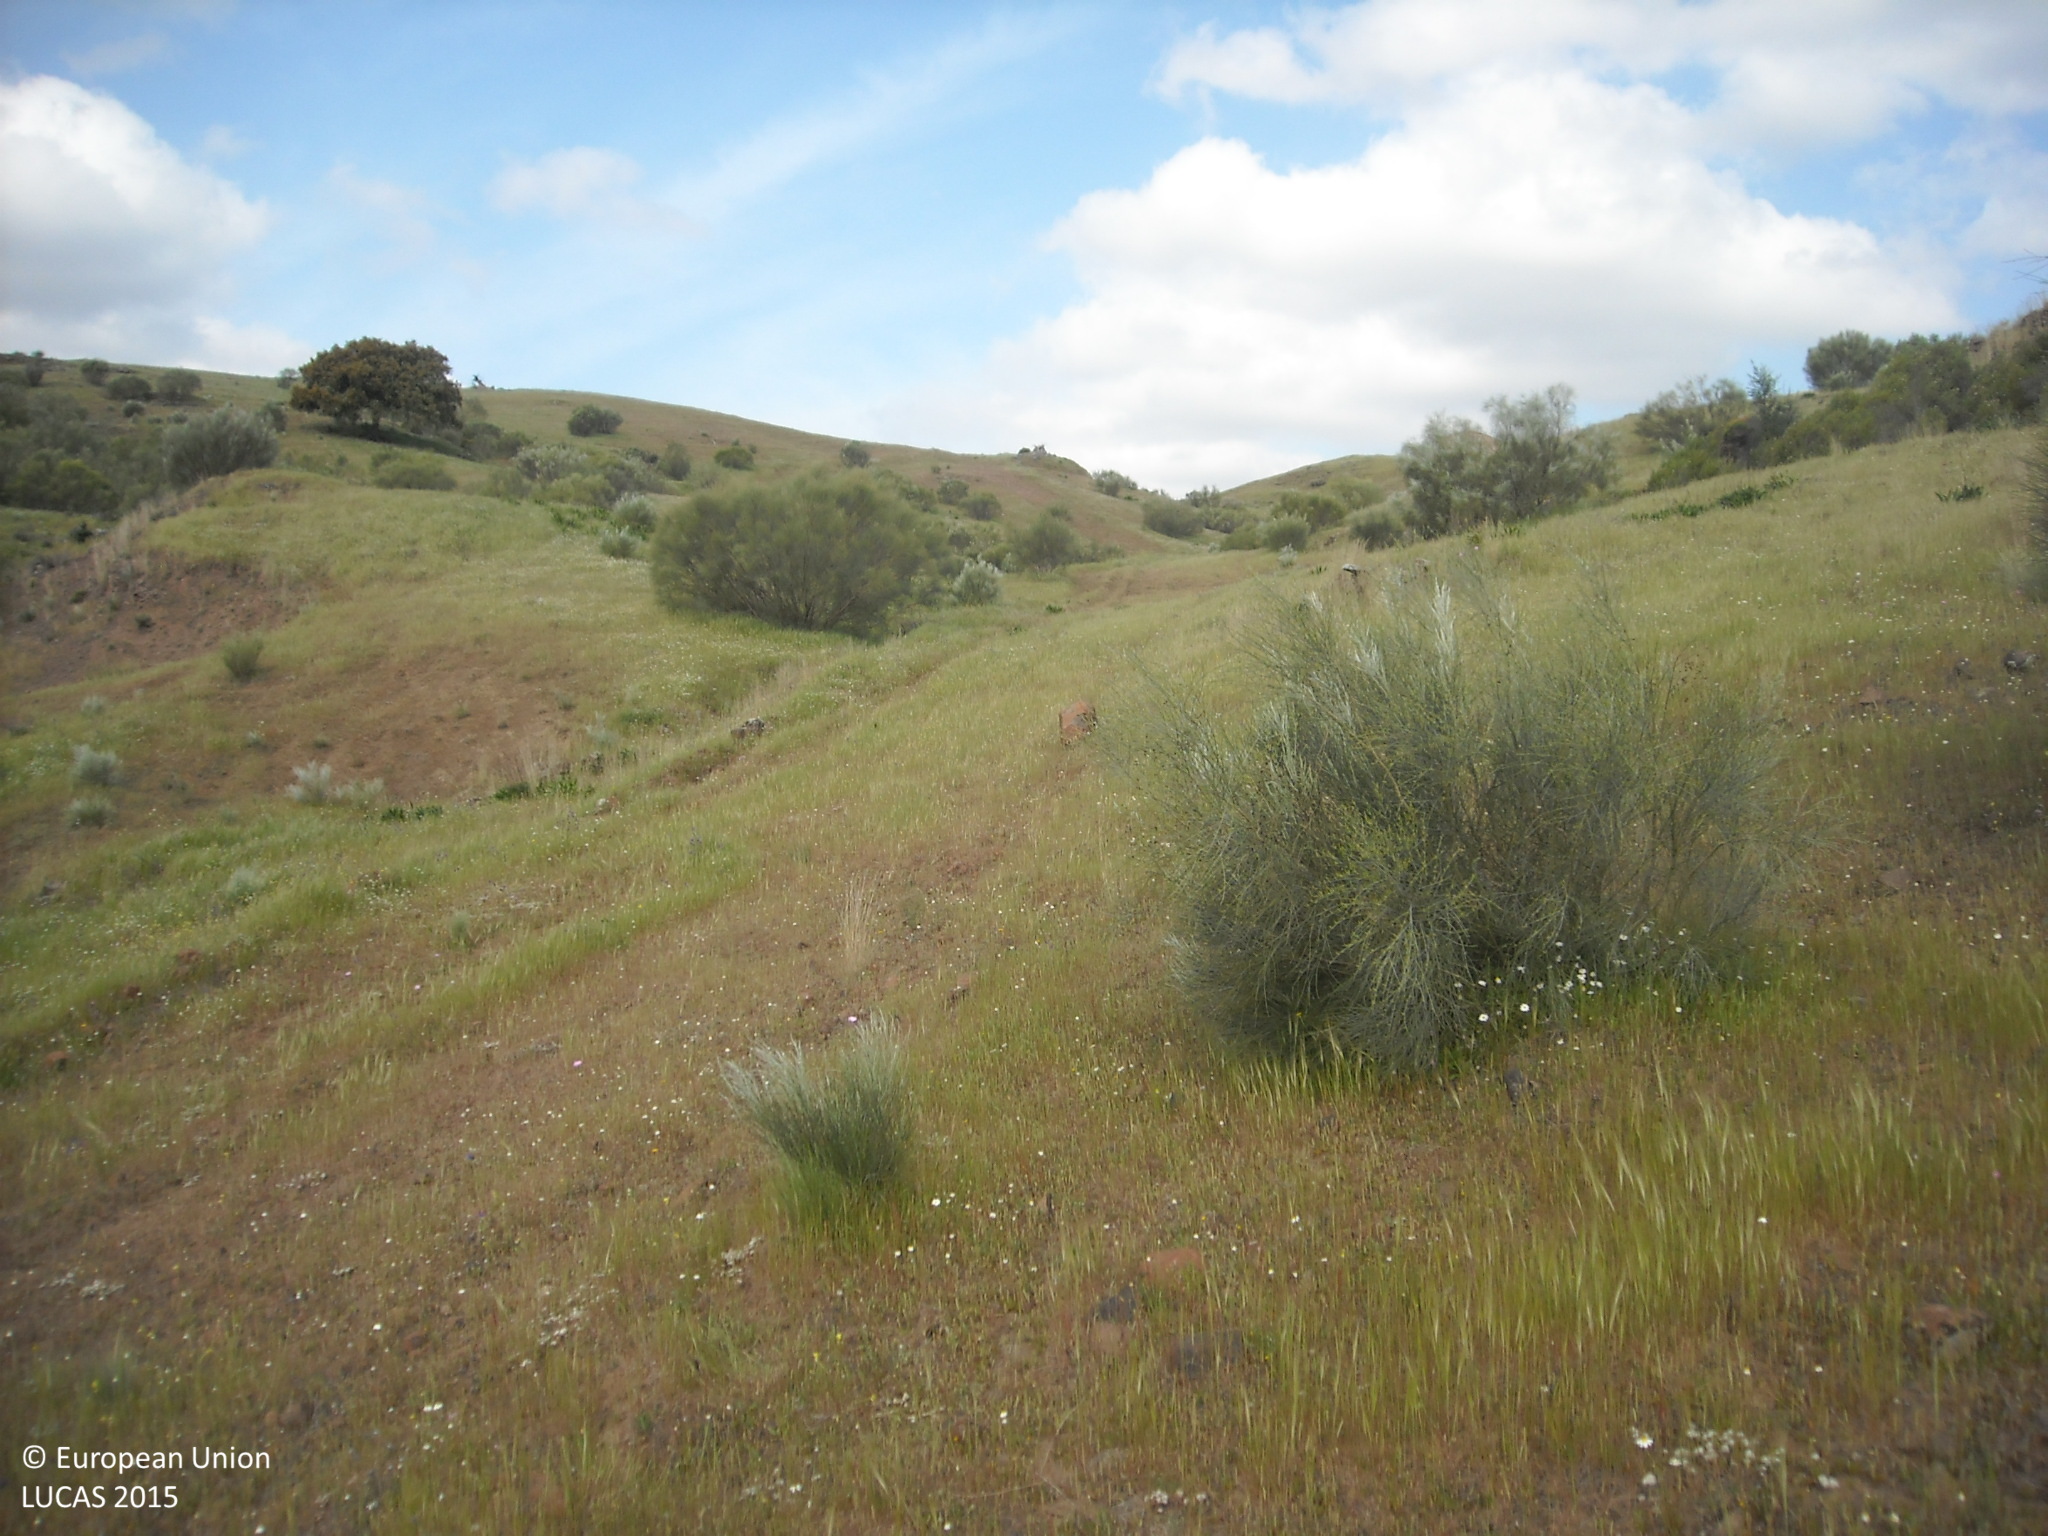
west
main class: Grassland
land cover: Grassland without tree/shrub cover
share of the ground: 50 - 75 %
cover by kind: herbaceous plants 70 %, consolidated bare surface 30 %
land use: Agriculture (excluding fallow land and kitchen gardens)
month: April
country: ES
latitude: 37.8578
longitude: -6.0019
